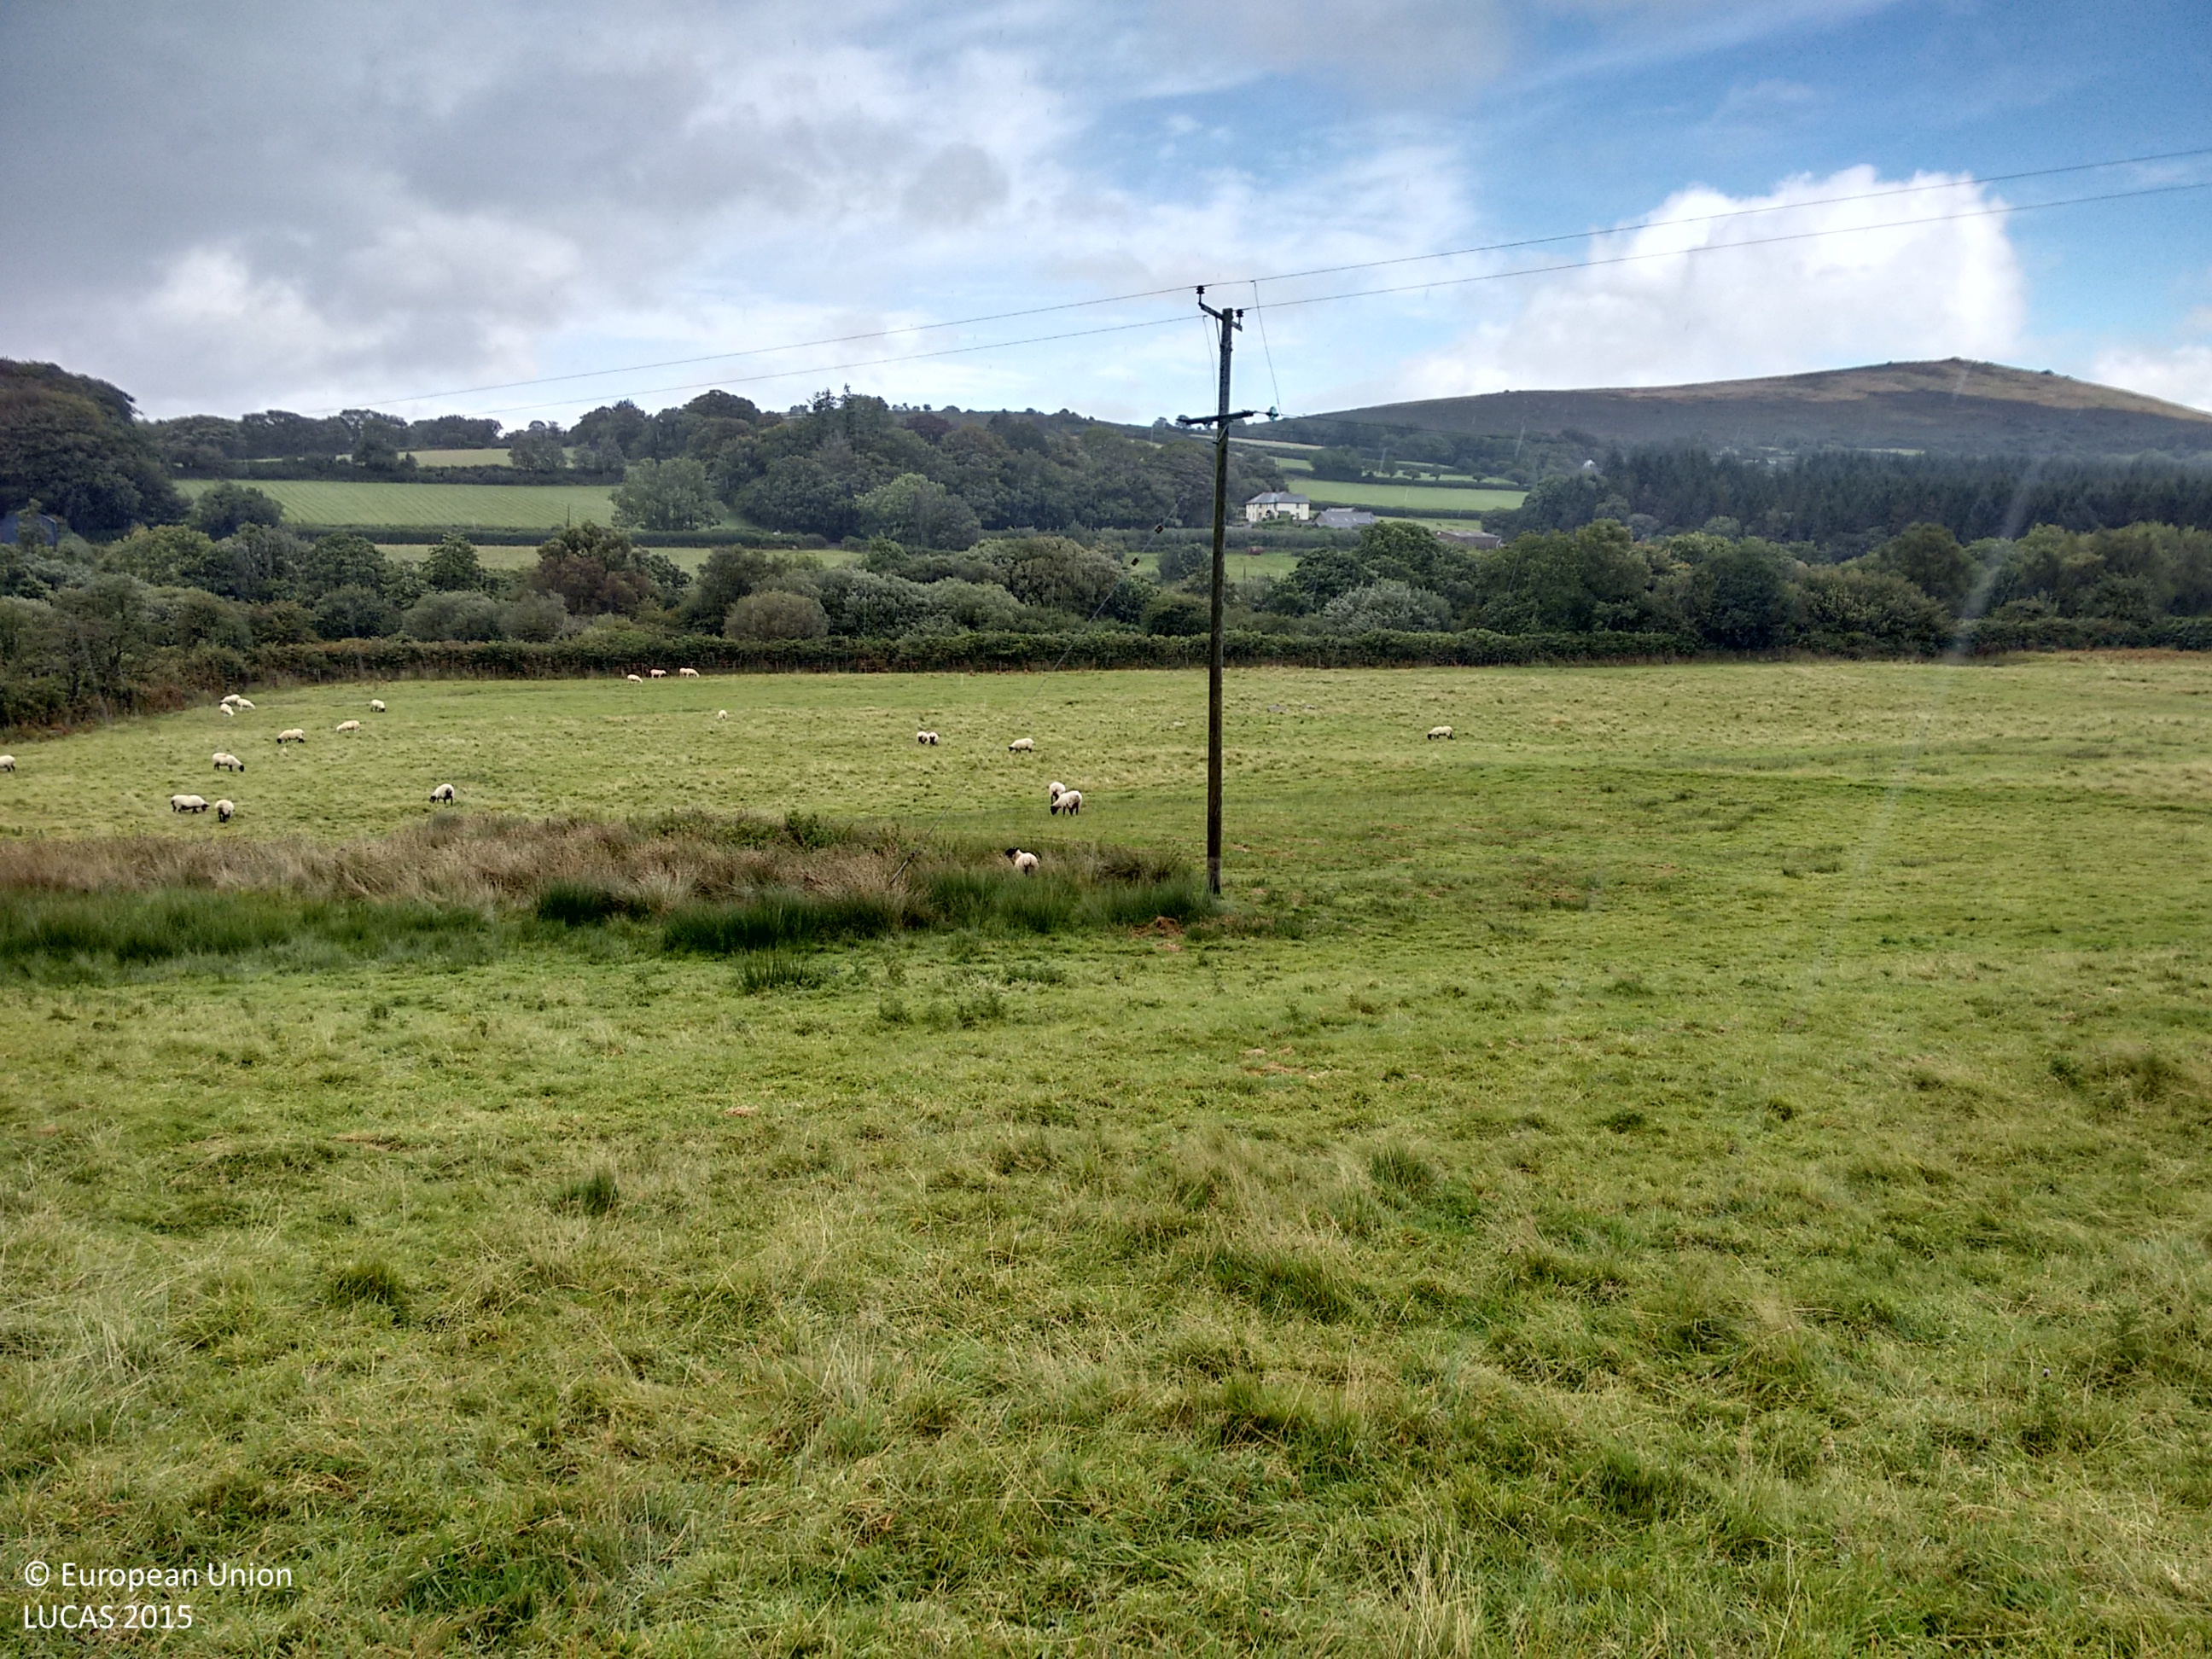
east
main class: Grassland
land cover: Grassland without tree/shrub cover
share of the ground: > 75 %
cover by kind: herbaceous plants 100 %
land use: Agriculture (excluding fallow land and kitchen gardens)
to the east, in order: Grassland without tree/shrub cover; Electric lines; Grassland without tree/shrub cover; Fences; Managed hedges; Broadleaved woodland; Inland fresh running water; Broadleaved woodland; Grassland without tree/shrub cover
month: September
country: GB
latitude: 50.6333
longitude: -3.8184
